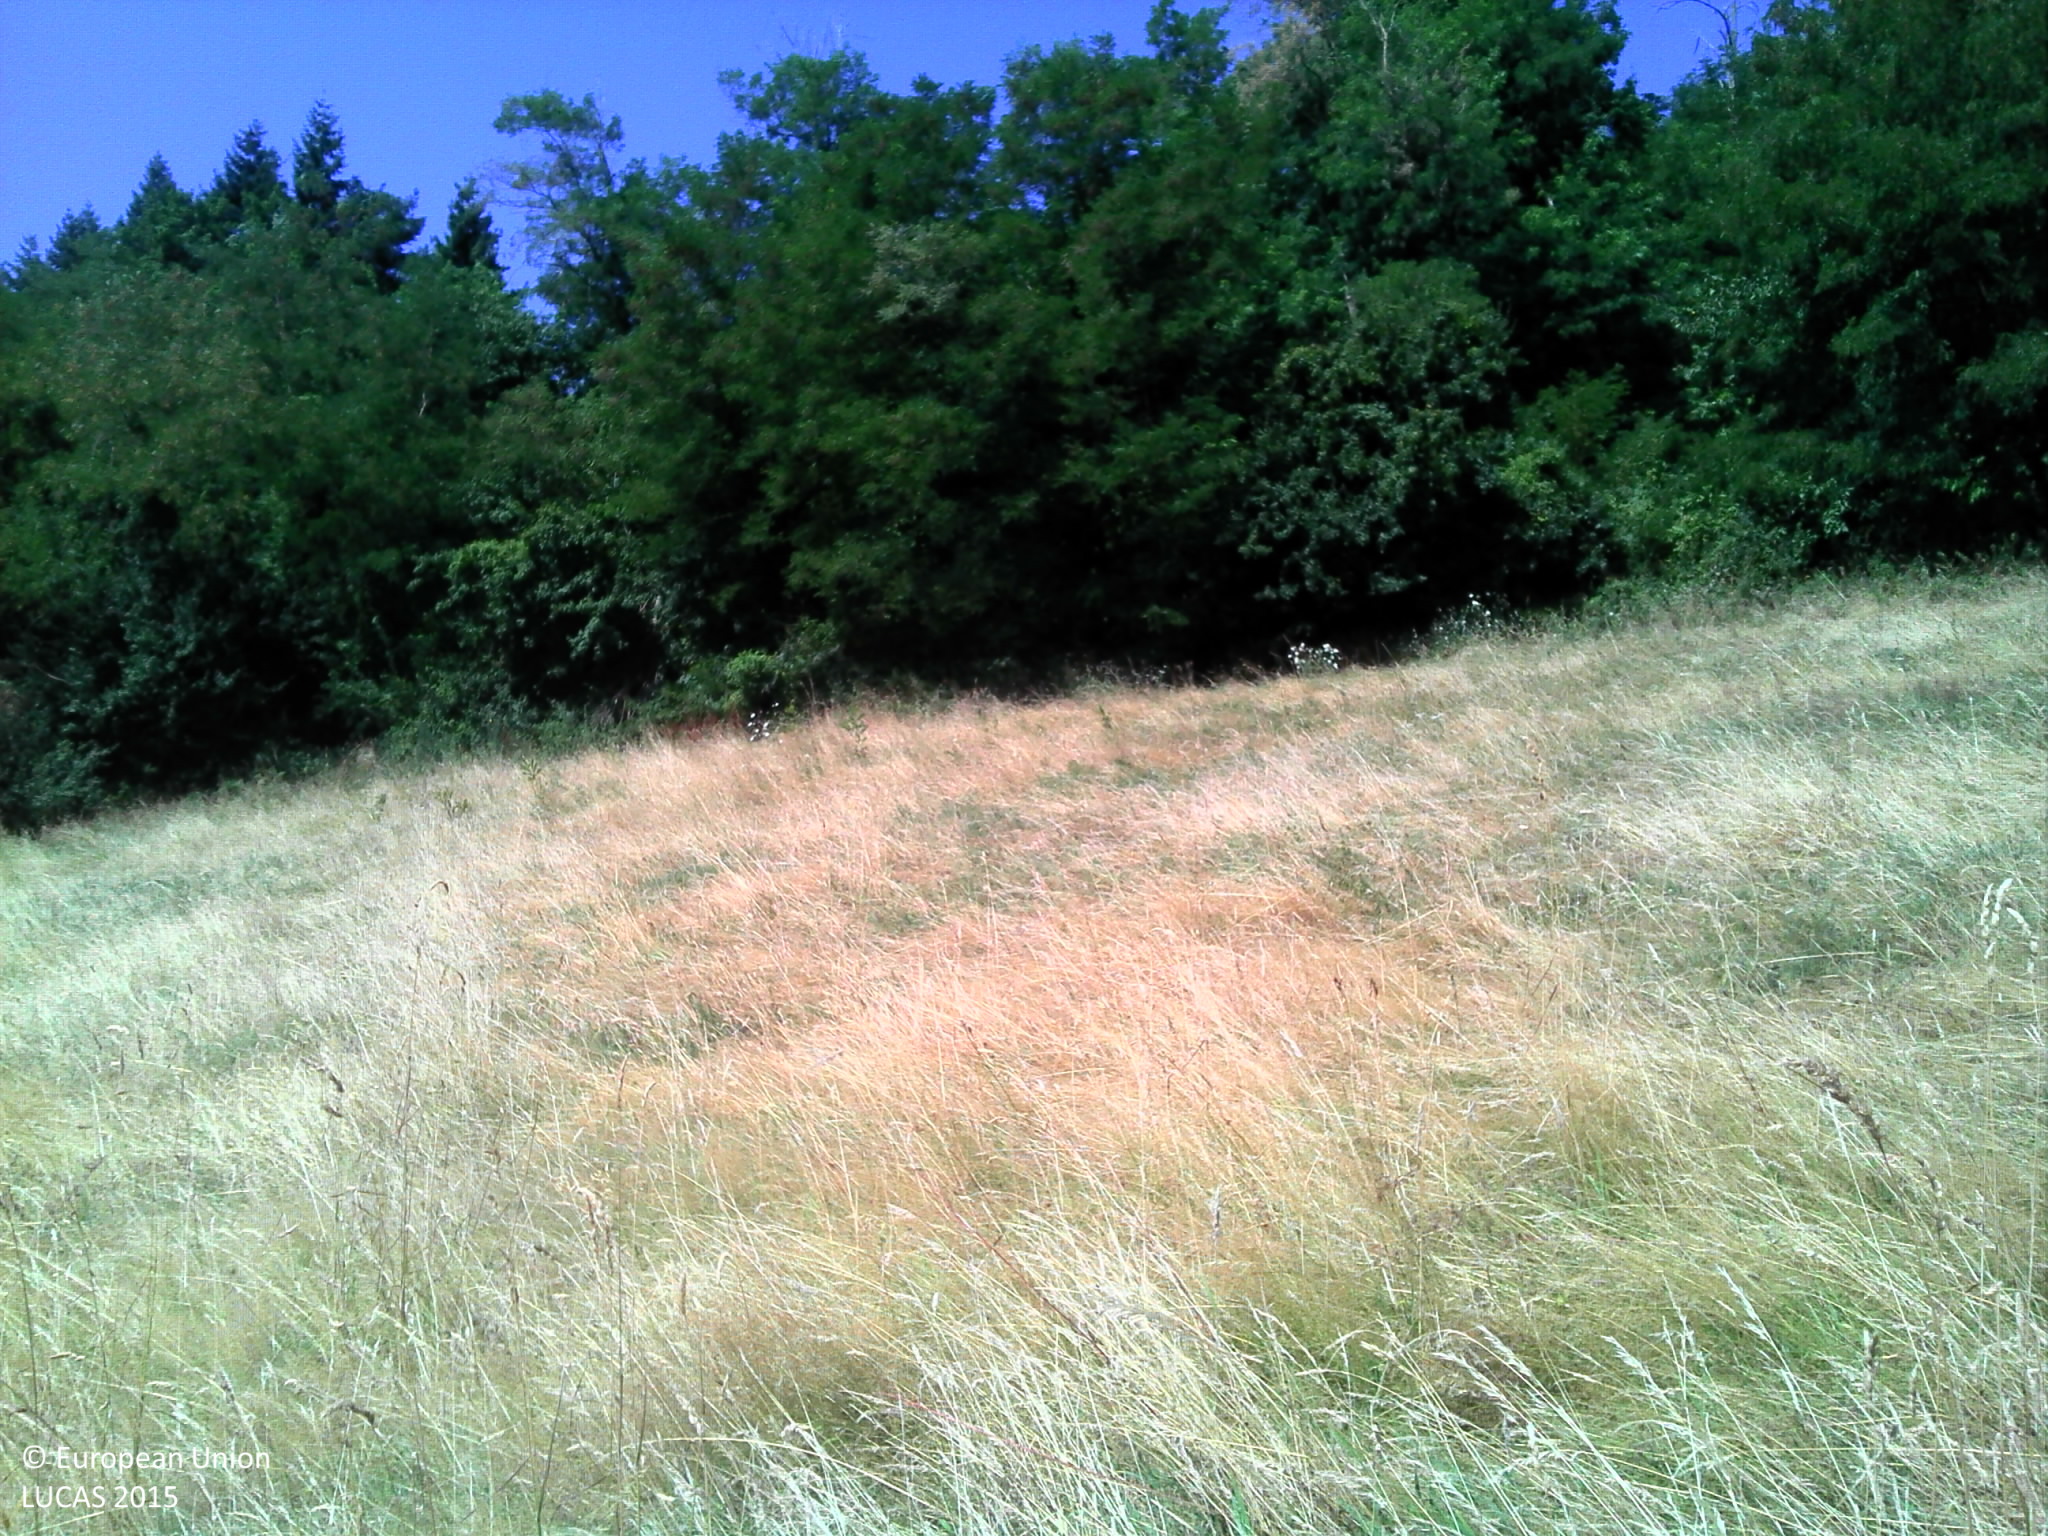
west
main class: Grassland
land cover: Grassland without tree/shrub cover
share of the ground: > 75 %
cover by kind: herbaceous plants 100 %
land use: Agriculture (excluding fallow land and kitchen gardens)
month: July
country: FR
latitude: 45.4307
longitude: 5.1858
